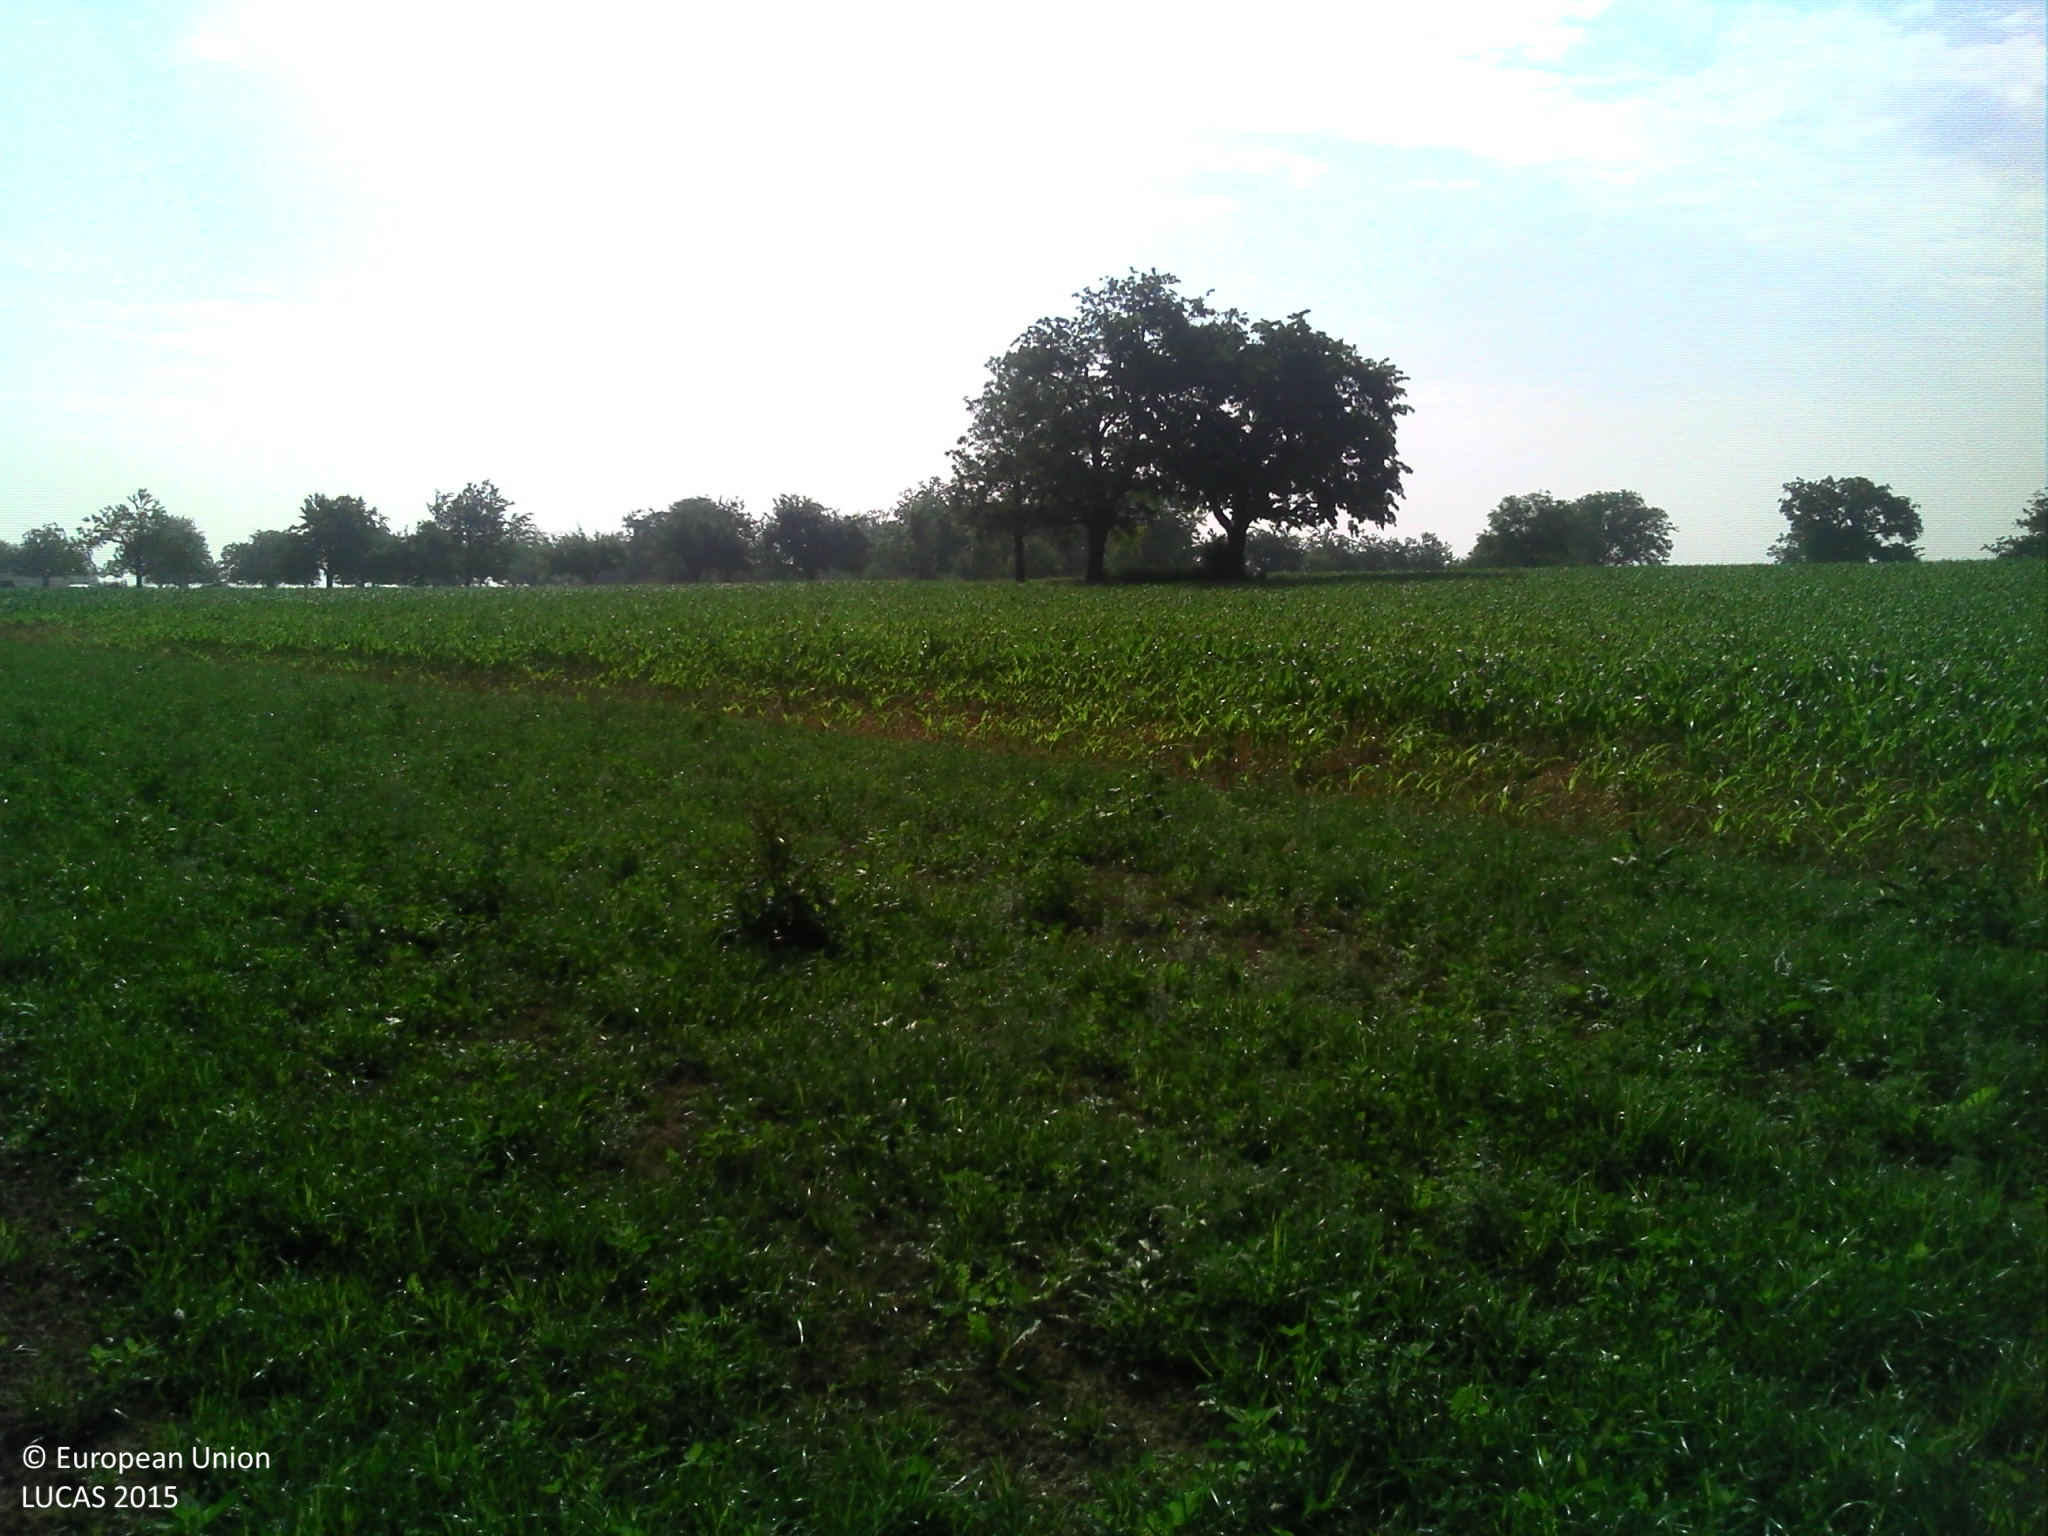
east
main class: Cropland
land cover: Temporary grasslands
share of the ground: > 75 %
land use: Agriculture (excluding fallow land and kitchen gardens)
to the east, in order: Temporary grasslands; Maize; Grassland without tree/shrub cover; Ditches and canals; Grass margins; Paved roads, cycling and walking lanes; Grass margins; Ditches and canals; Apple fruit; Grassland with sparse tree/shrub cover; Maize; Apple fruit; Temporary grasslands; Grass margins; Tracks; Grass margins; Fences; Grassland without tree/shrub cover
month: June
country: FR
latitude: 47.5809
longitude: 7.4090
